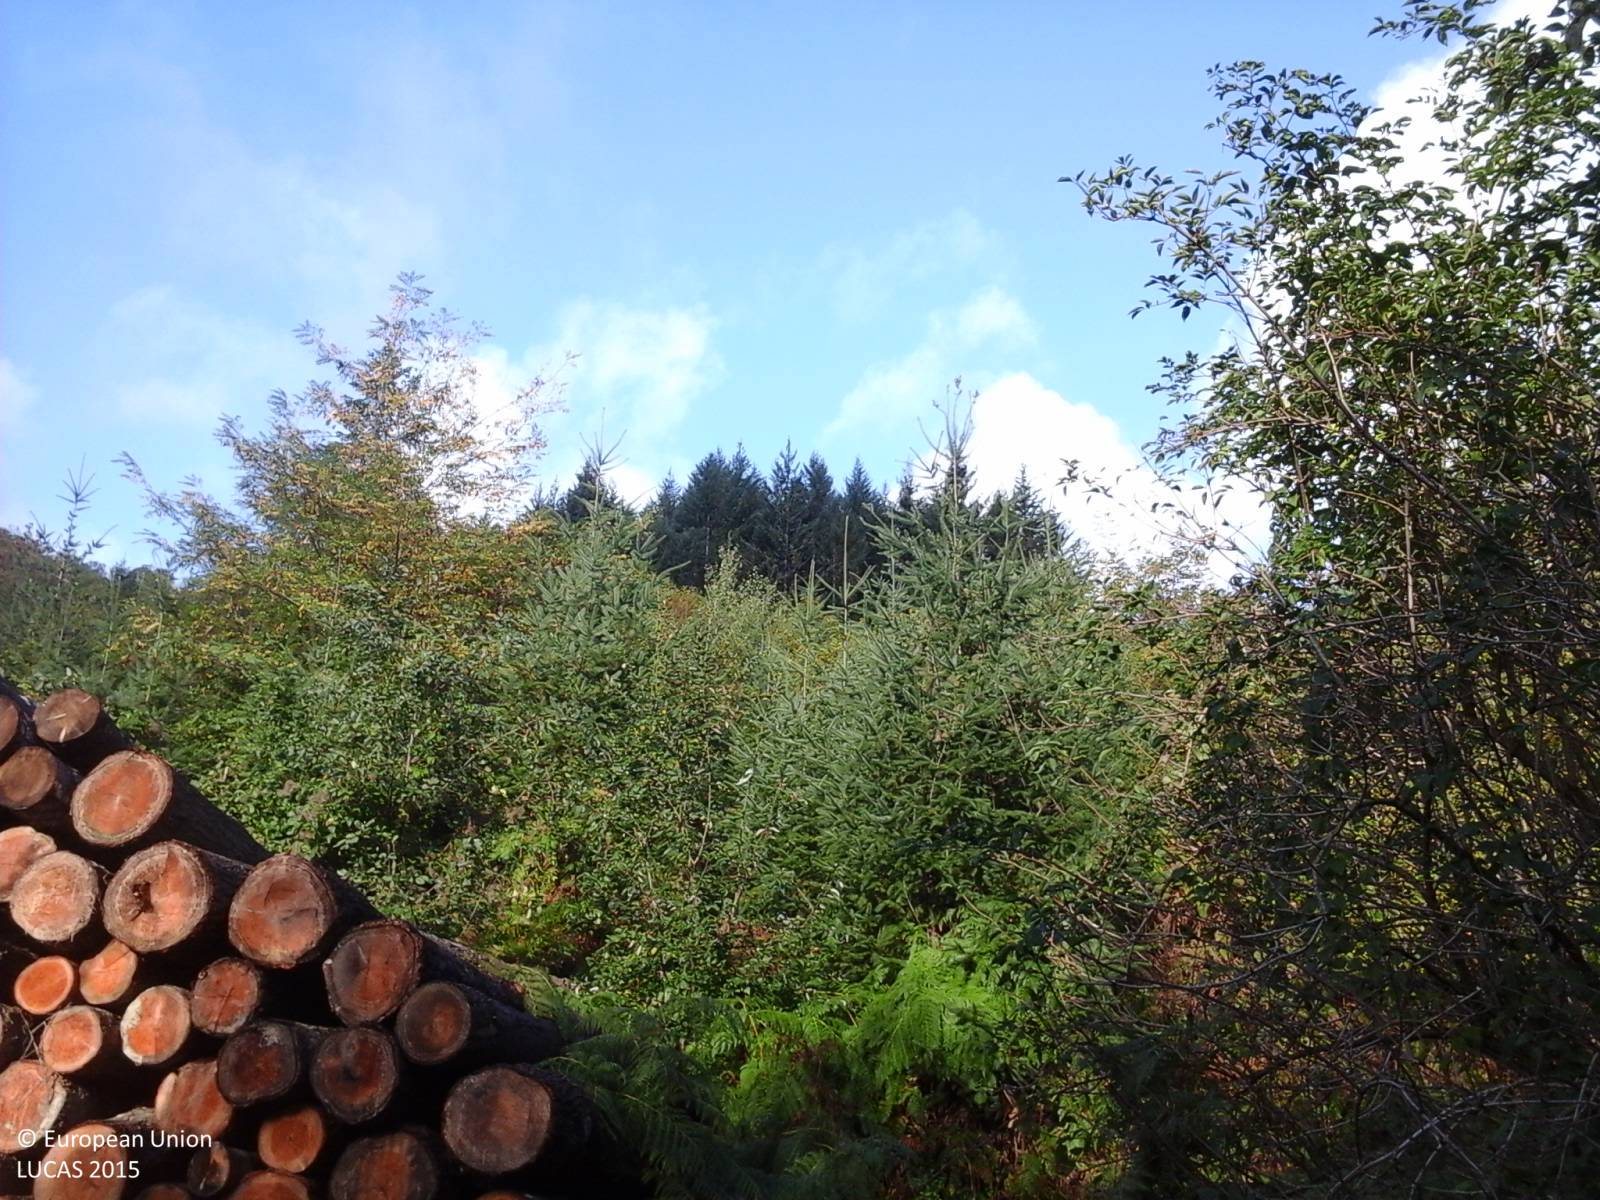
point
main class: Woodland
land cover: Other coniferous woodland
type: alpine coniferous forest
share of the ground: > 75 %
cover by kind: coniferous forest trees 100 %
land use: Forestry
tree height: > 5 m
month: October
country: IT
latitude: 43.7060
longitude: 11.6462
